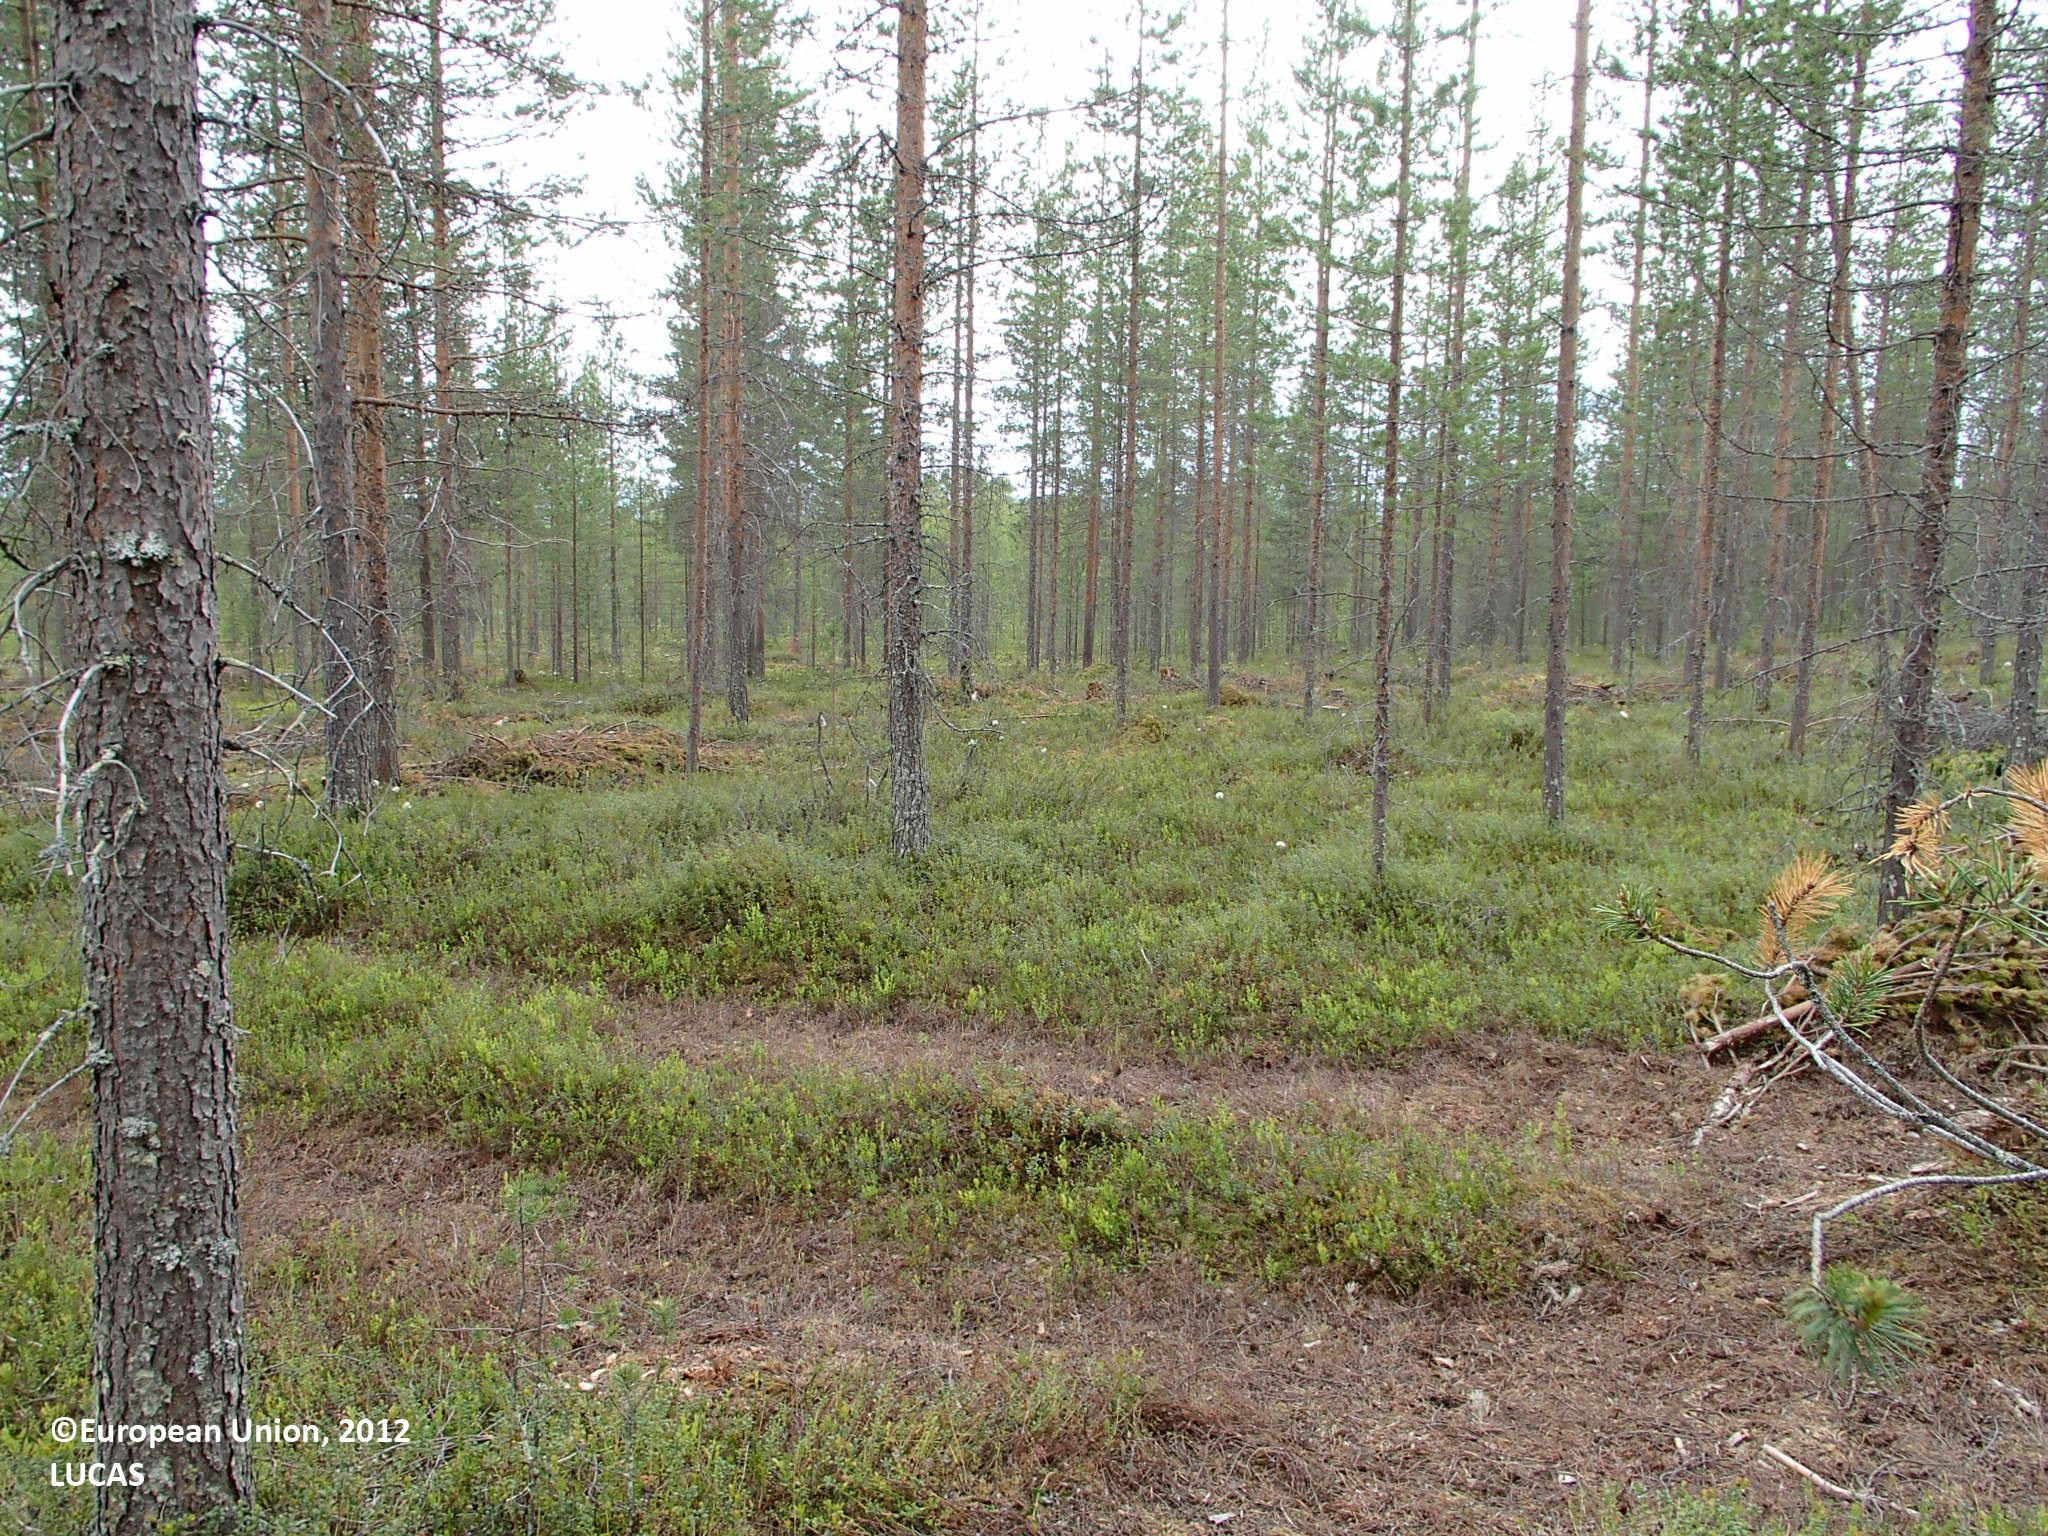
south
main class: Woodland
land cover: Pine dominated coniferous woodland
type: boreal forest
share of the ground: > 75 %
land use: Forestry
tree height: > 5 m
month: June
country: FI
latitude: 66.5895
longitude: 27.7817
